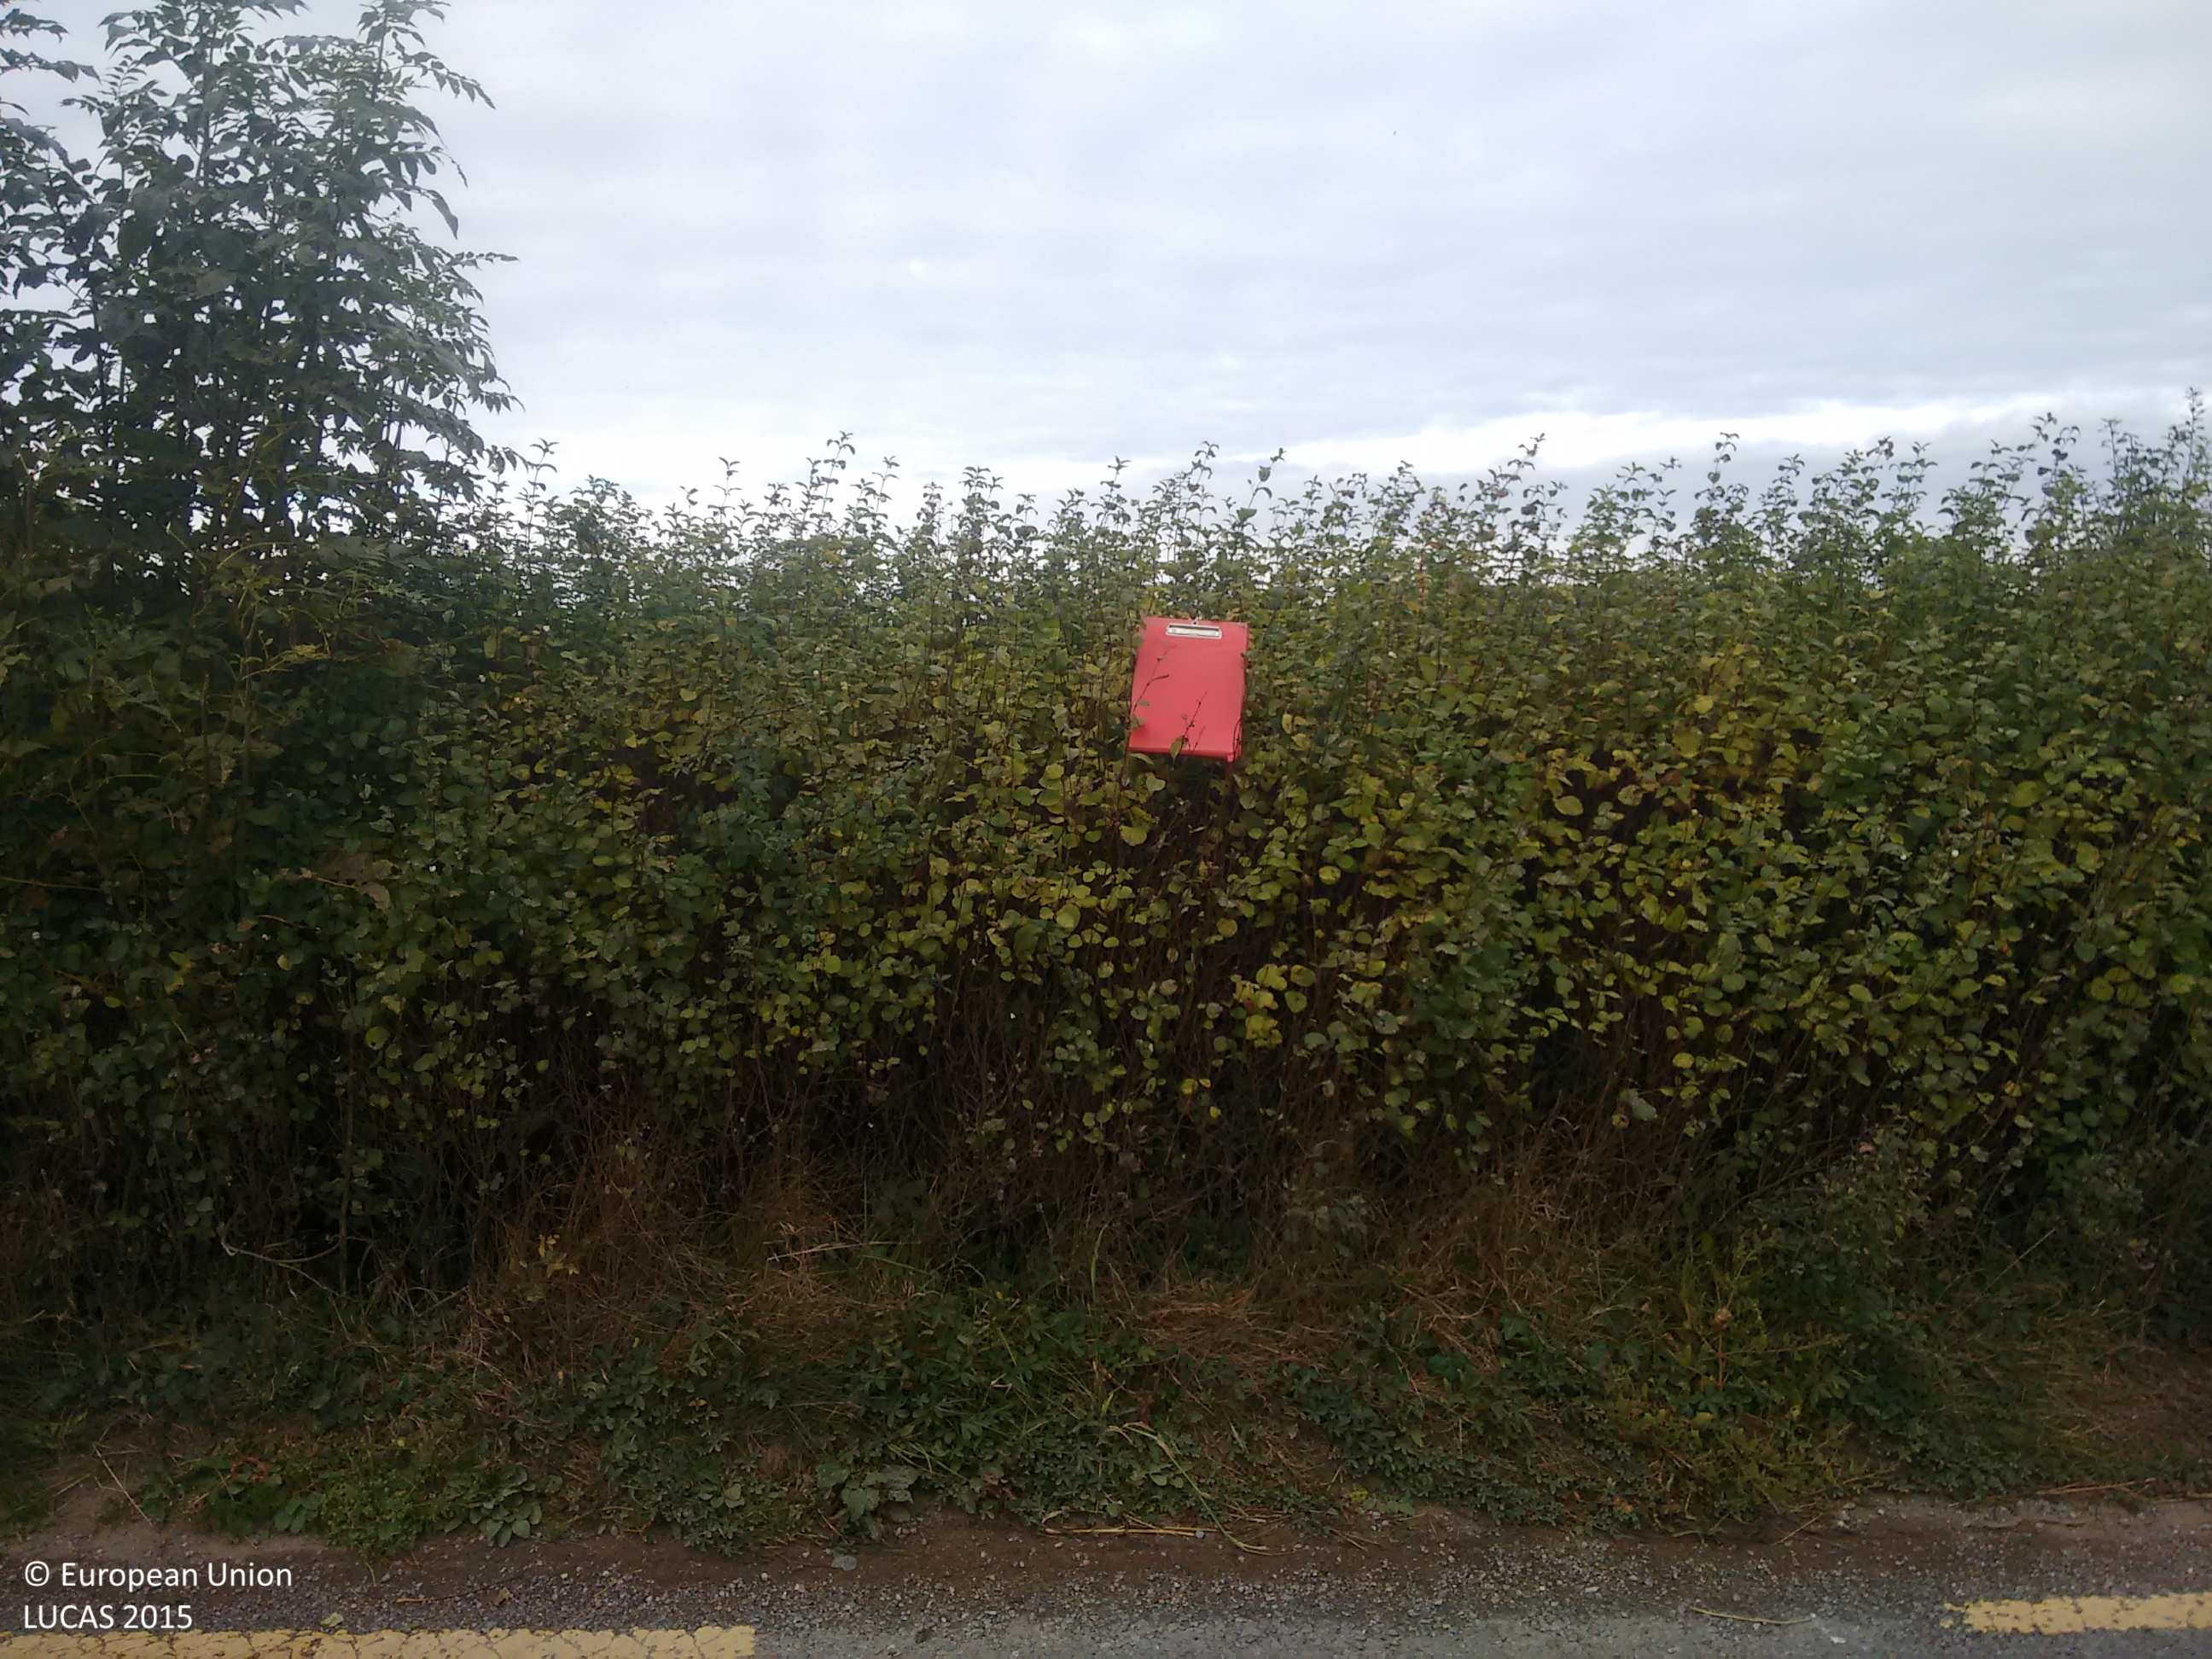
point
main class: Grassland
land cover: Grassland without tree/shrub cover
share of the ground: > 75 %
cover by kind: herbaceous plants 75 %, consolidated bare surface 20 %, shrubs 5 %
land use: Agriculture (excluding fallow land and kitchen gardens)
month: October
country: IE
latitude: 52.8732
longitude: -7.4661
